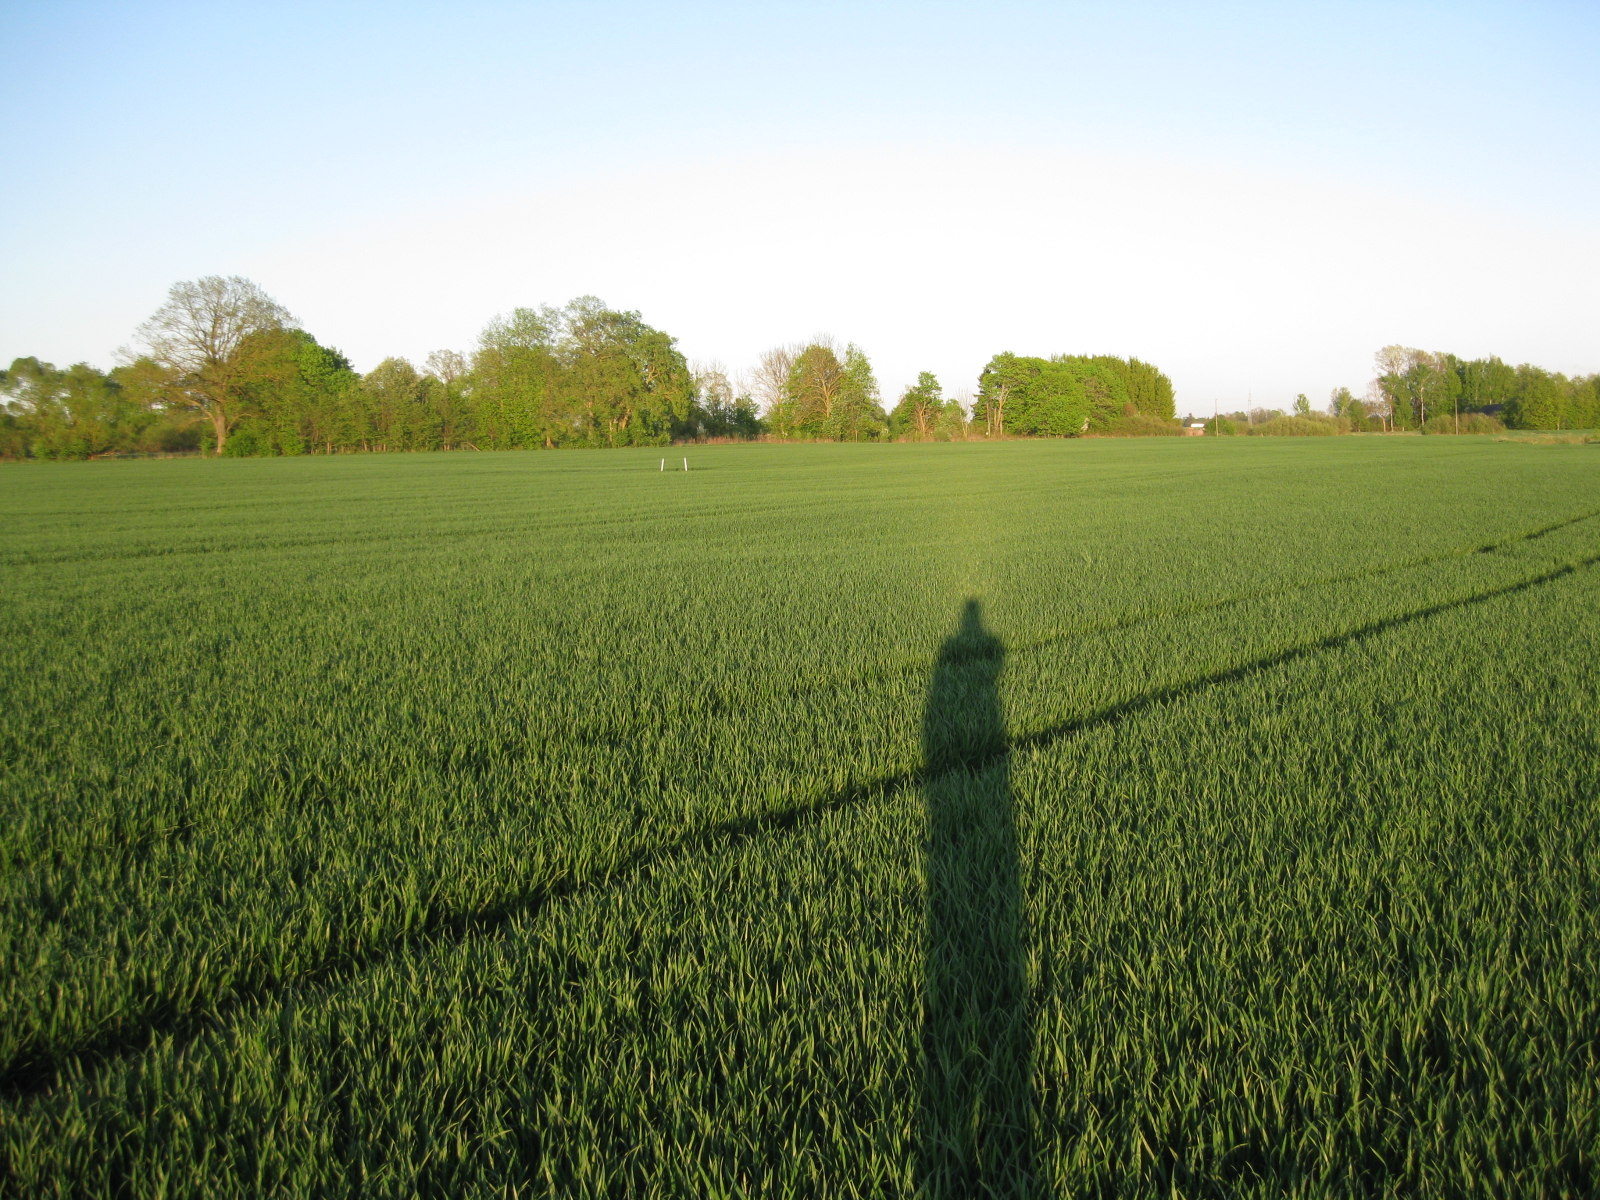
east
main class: Cropland
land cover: Common wheat
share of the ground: > 75 %
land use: Agriculture (excluding fallow land and kitchen gardens)
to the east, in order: Common wheat; Broadleaved woodland; Grassland without tree/shrub cover; Broadleaved woodland
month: May
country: LT
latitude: 56.0993
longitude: 24.4197
